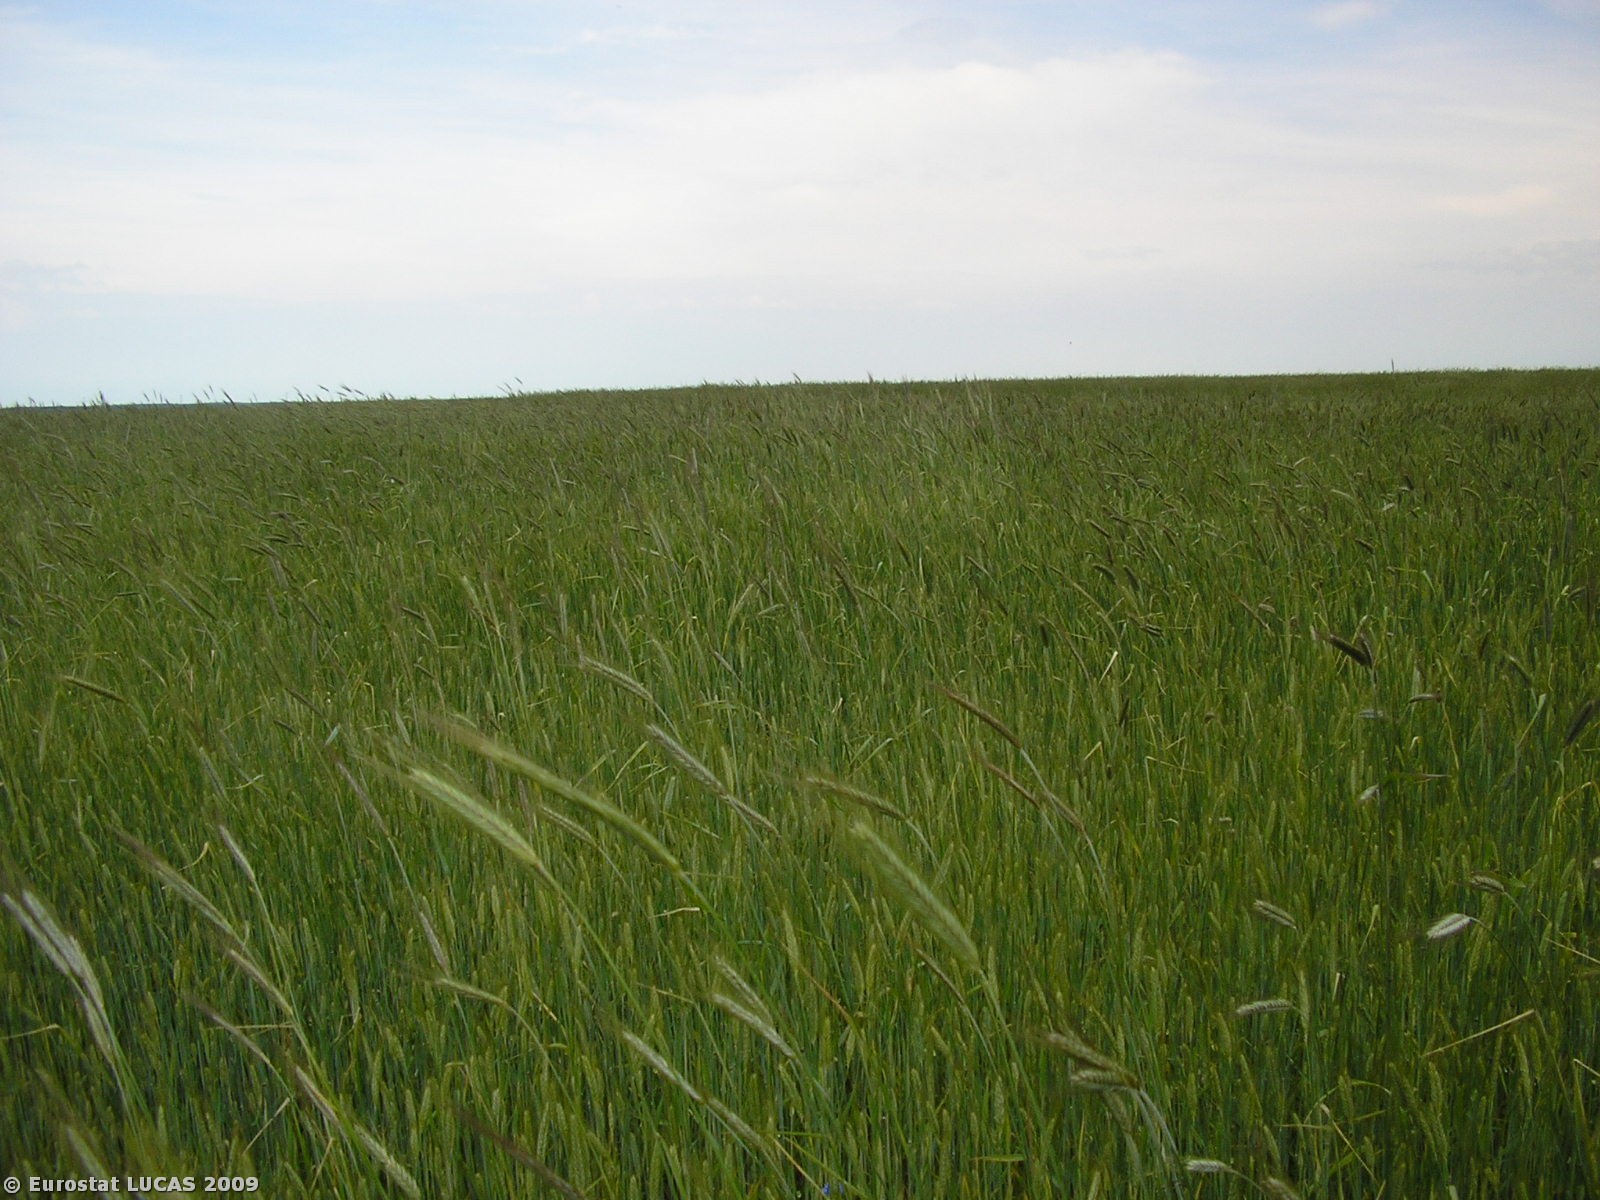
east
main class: Cropland
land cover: Triticale
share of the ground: 50 - 75 %
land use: Agriculture (excluding fallow land and kitchen gardens)
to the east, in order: Triticale; Electric lines; Triticale; Tracks; Barley; Other root crops; Grass margins; Oats; Grass margins; Rye; Grass margins; Rye; Grass margins; Barley; Grass margins; Mixed cereals for fodder; Grass margins; Mixed cereals for fodder; Grass margins; Mixed cereals for fodder; Grass margins; Triticale
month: June
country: PL
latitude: 51.0849
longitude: 18.8878
